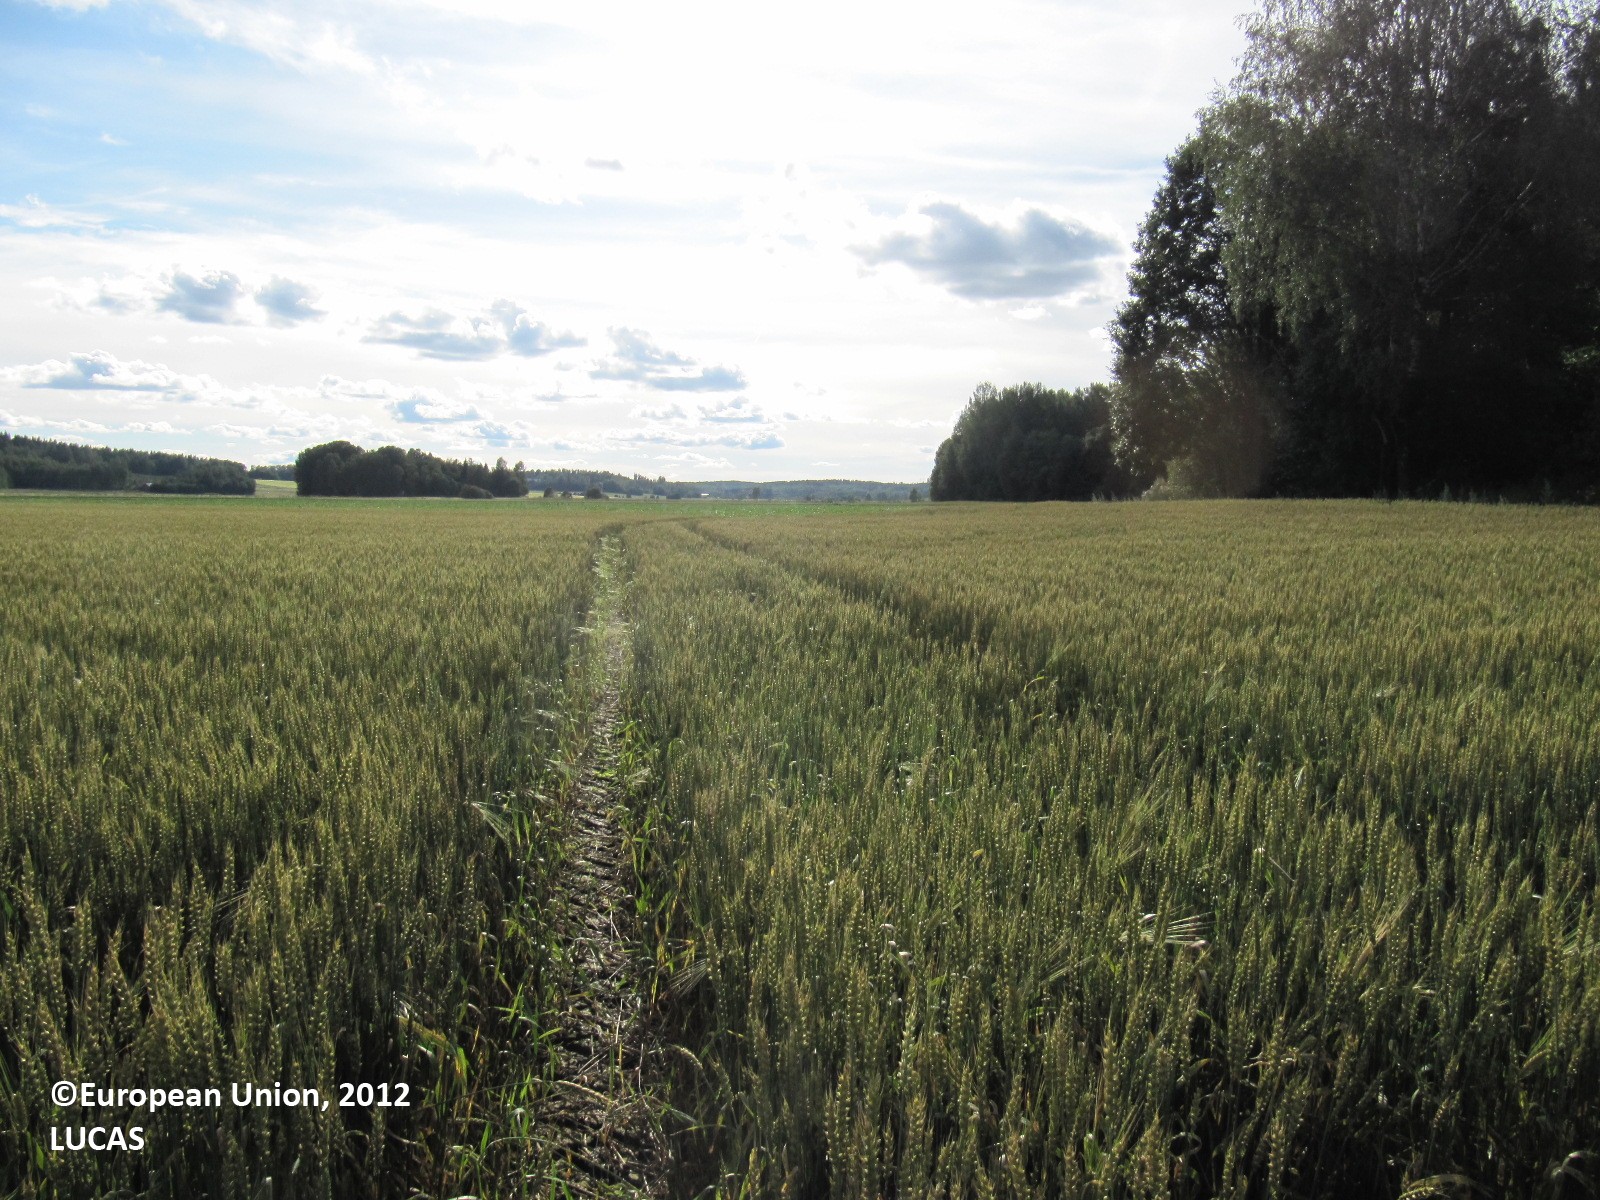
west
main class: Cropland
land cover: Common wheat
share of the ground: > 75 %
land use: Agriculture (excluding fallow land and kitchen gardens)
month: August
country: FI
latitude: 60.3240
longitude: 23.2107
